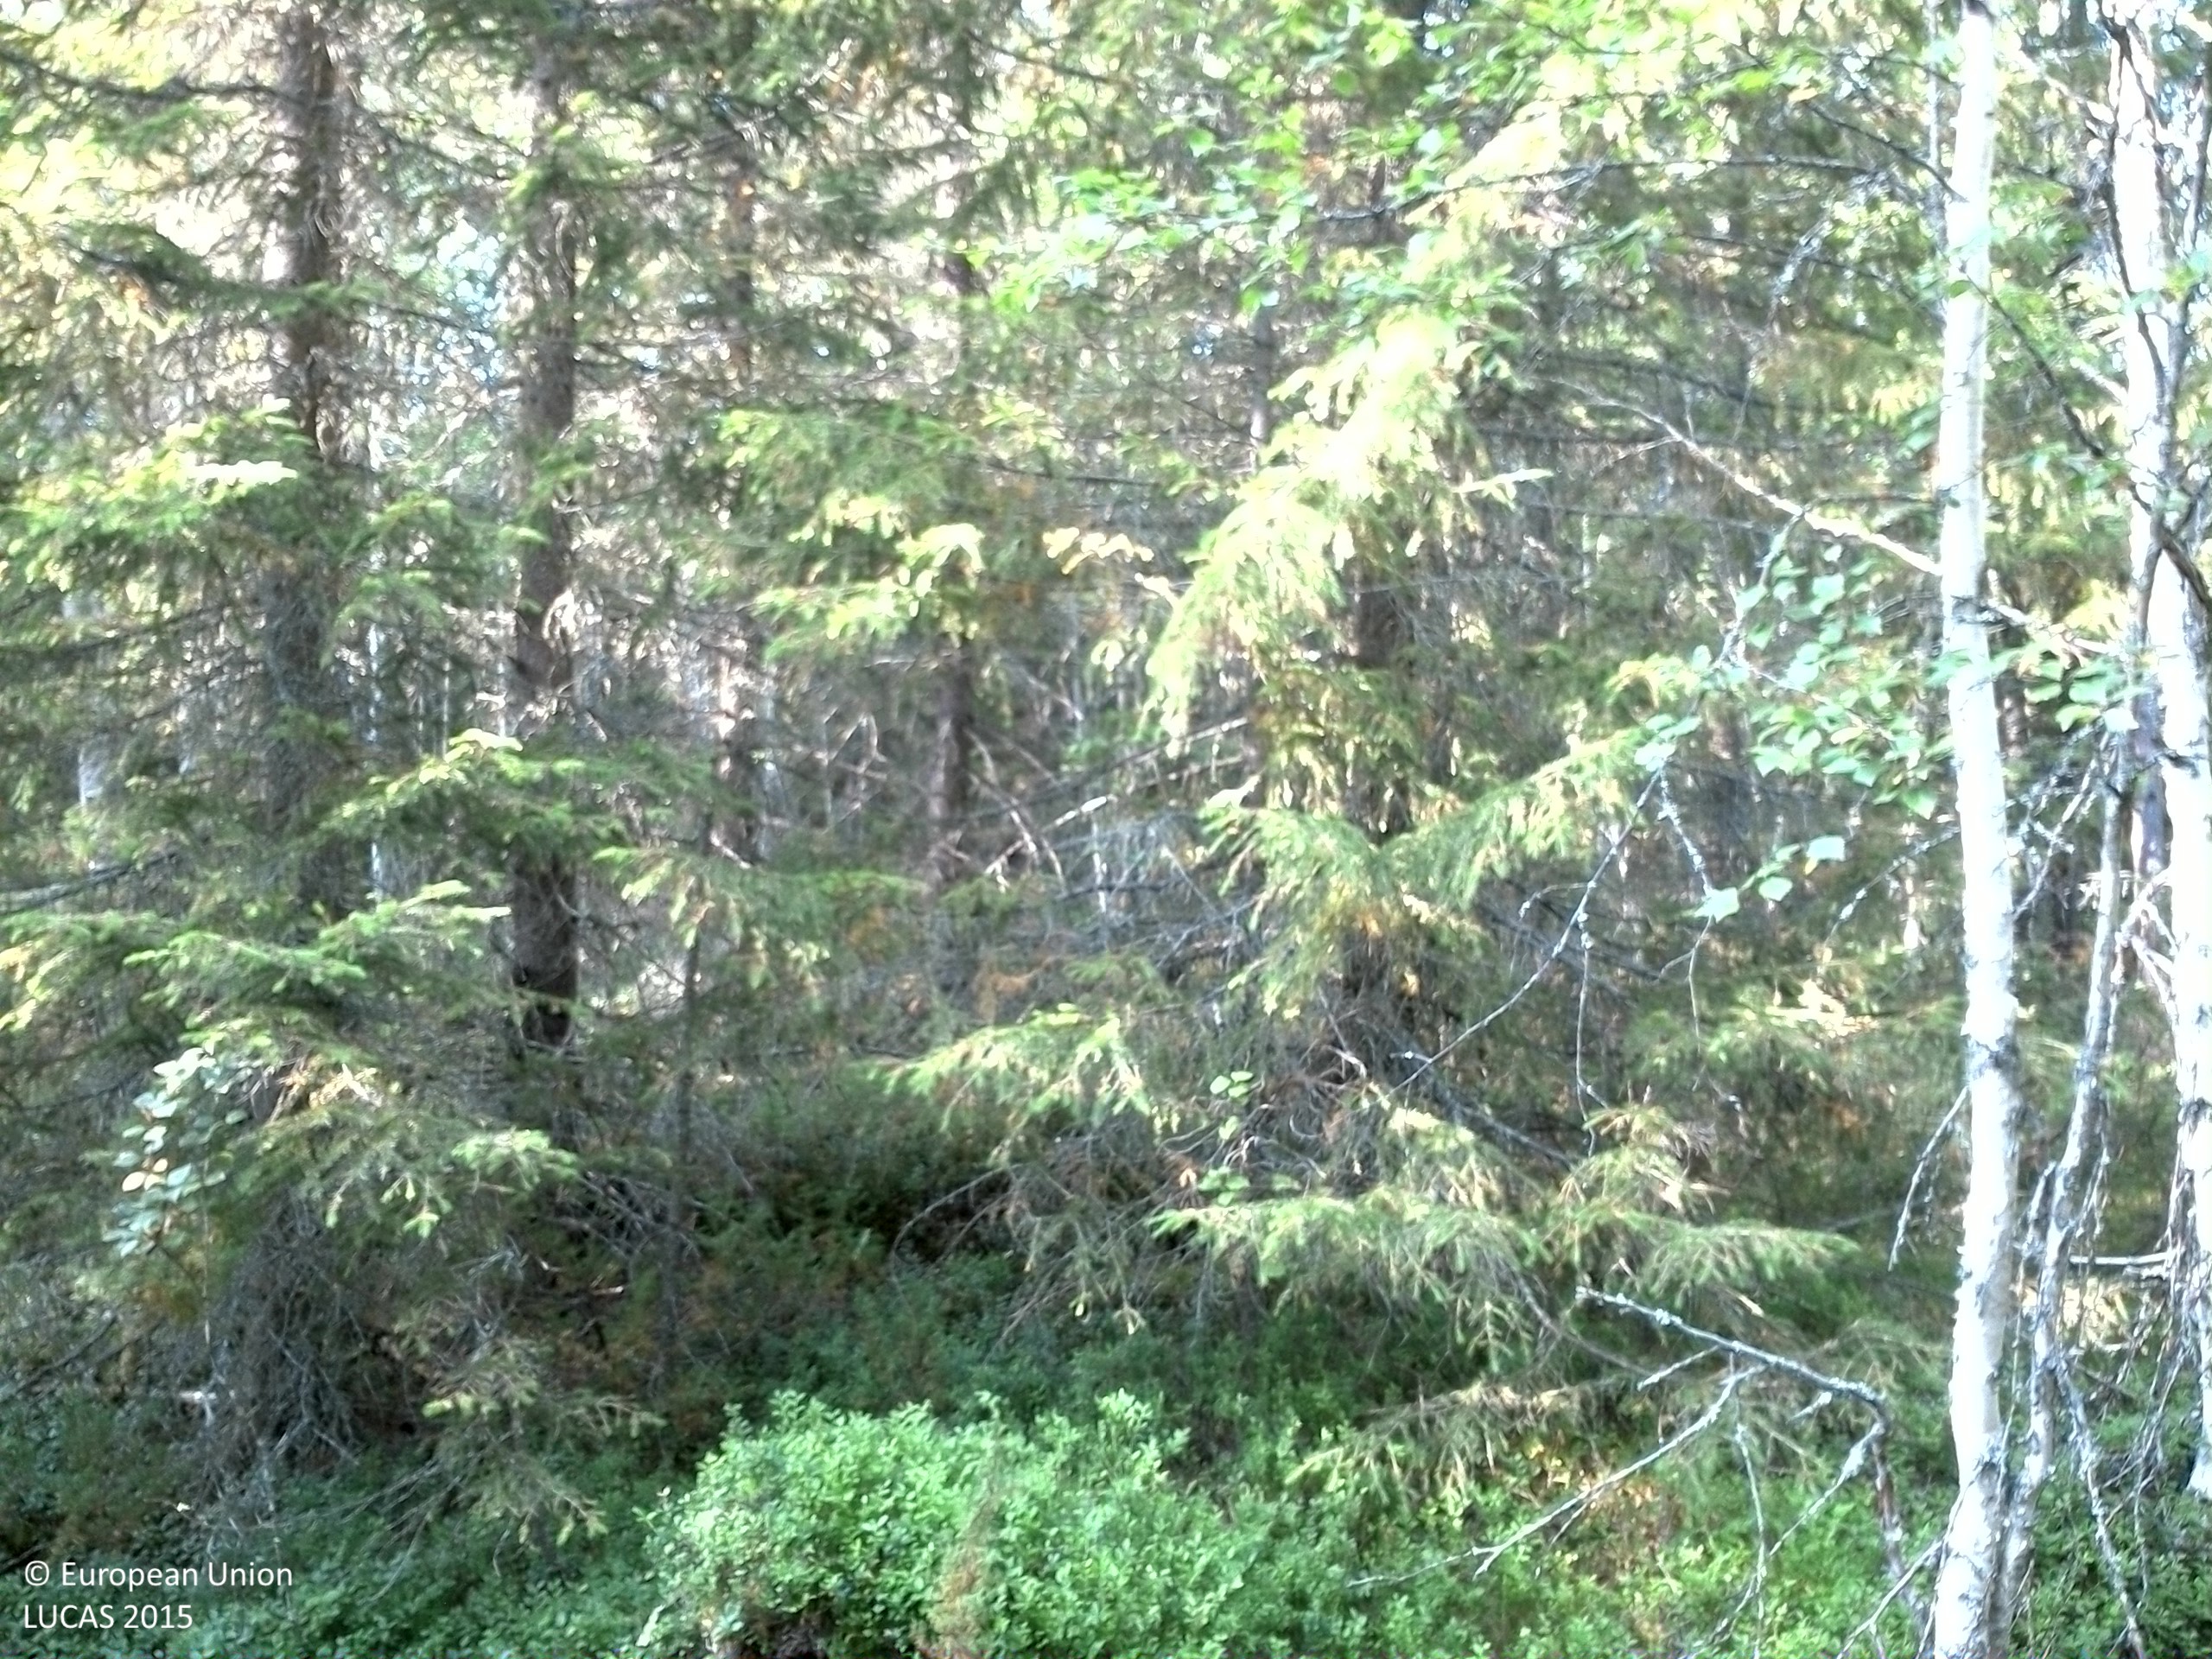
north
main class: Woodland
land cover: Other mixed woodland
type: boreal forest
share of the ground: > 75 %
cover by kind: coniferous forest trees 40 %, broadleaved forest trees 35 %, shrubs 20 %, lichens and mosses 5 %
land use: Forestry
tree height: > 5 m
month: August
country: SE
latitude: 63.8627
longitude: 17.3978
